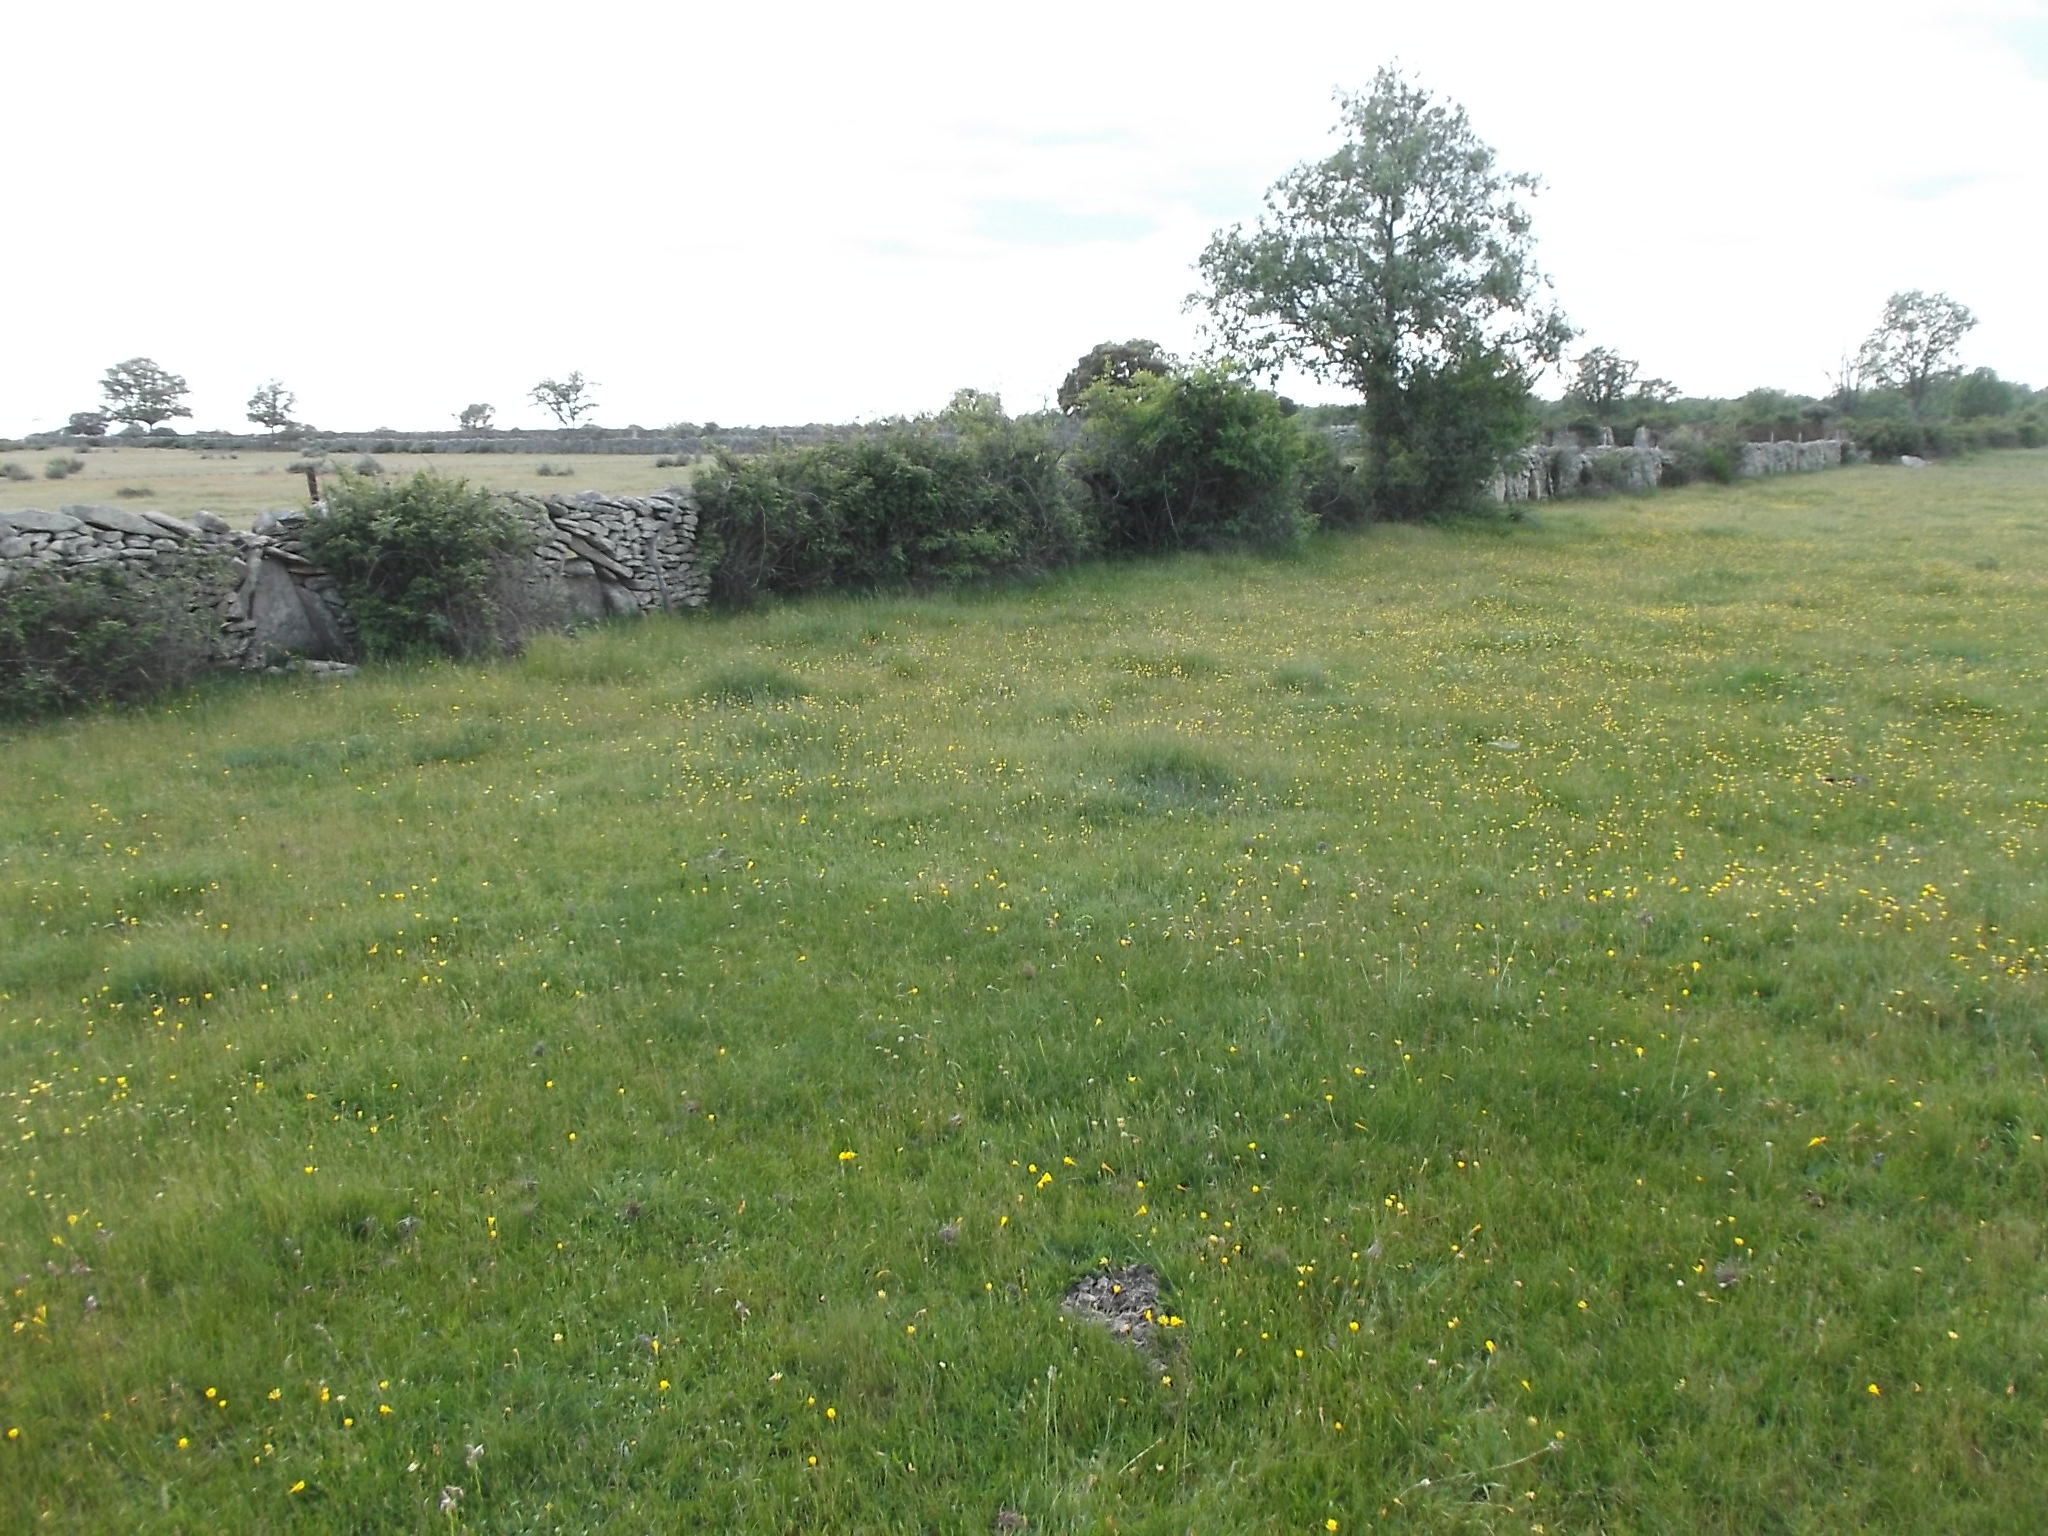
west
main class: Grassland
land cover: Grassland without tree/shrub cover
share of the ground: > 75 %
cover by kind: herbaceous plants 100 %
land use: Agriculture (excluding fallow land and kitchen gardens)
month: May
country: ES
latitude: 41.1557
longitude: -6.3119
